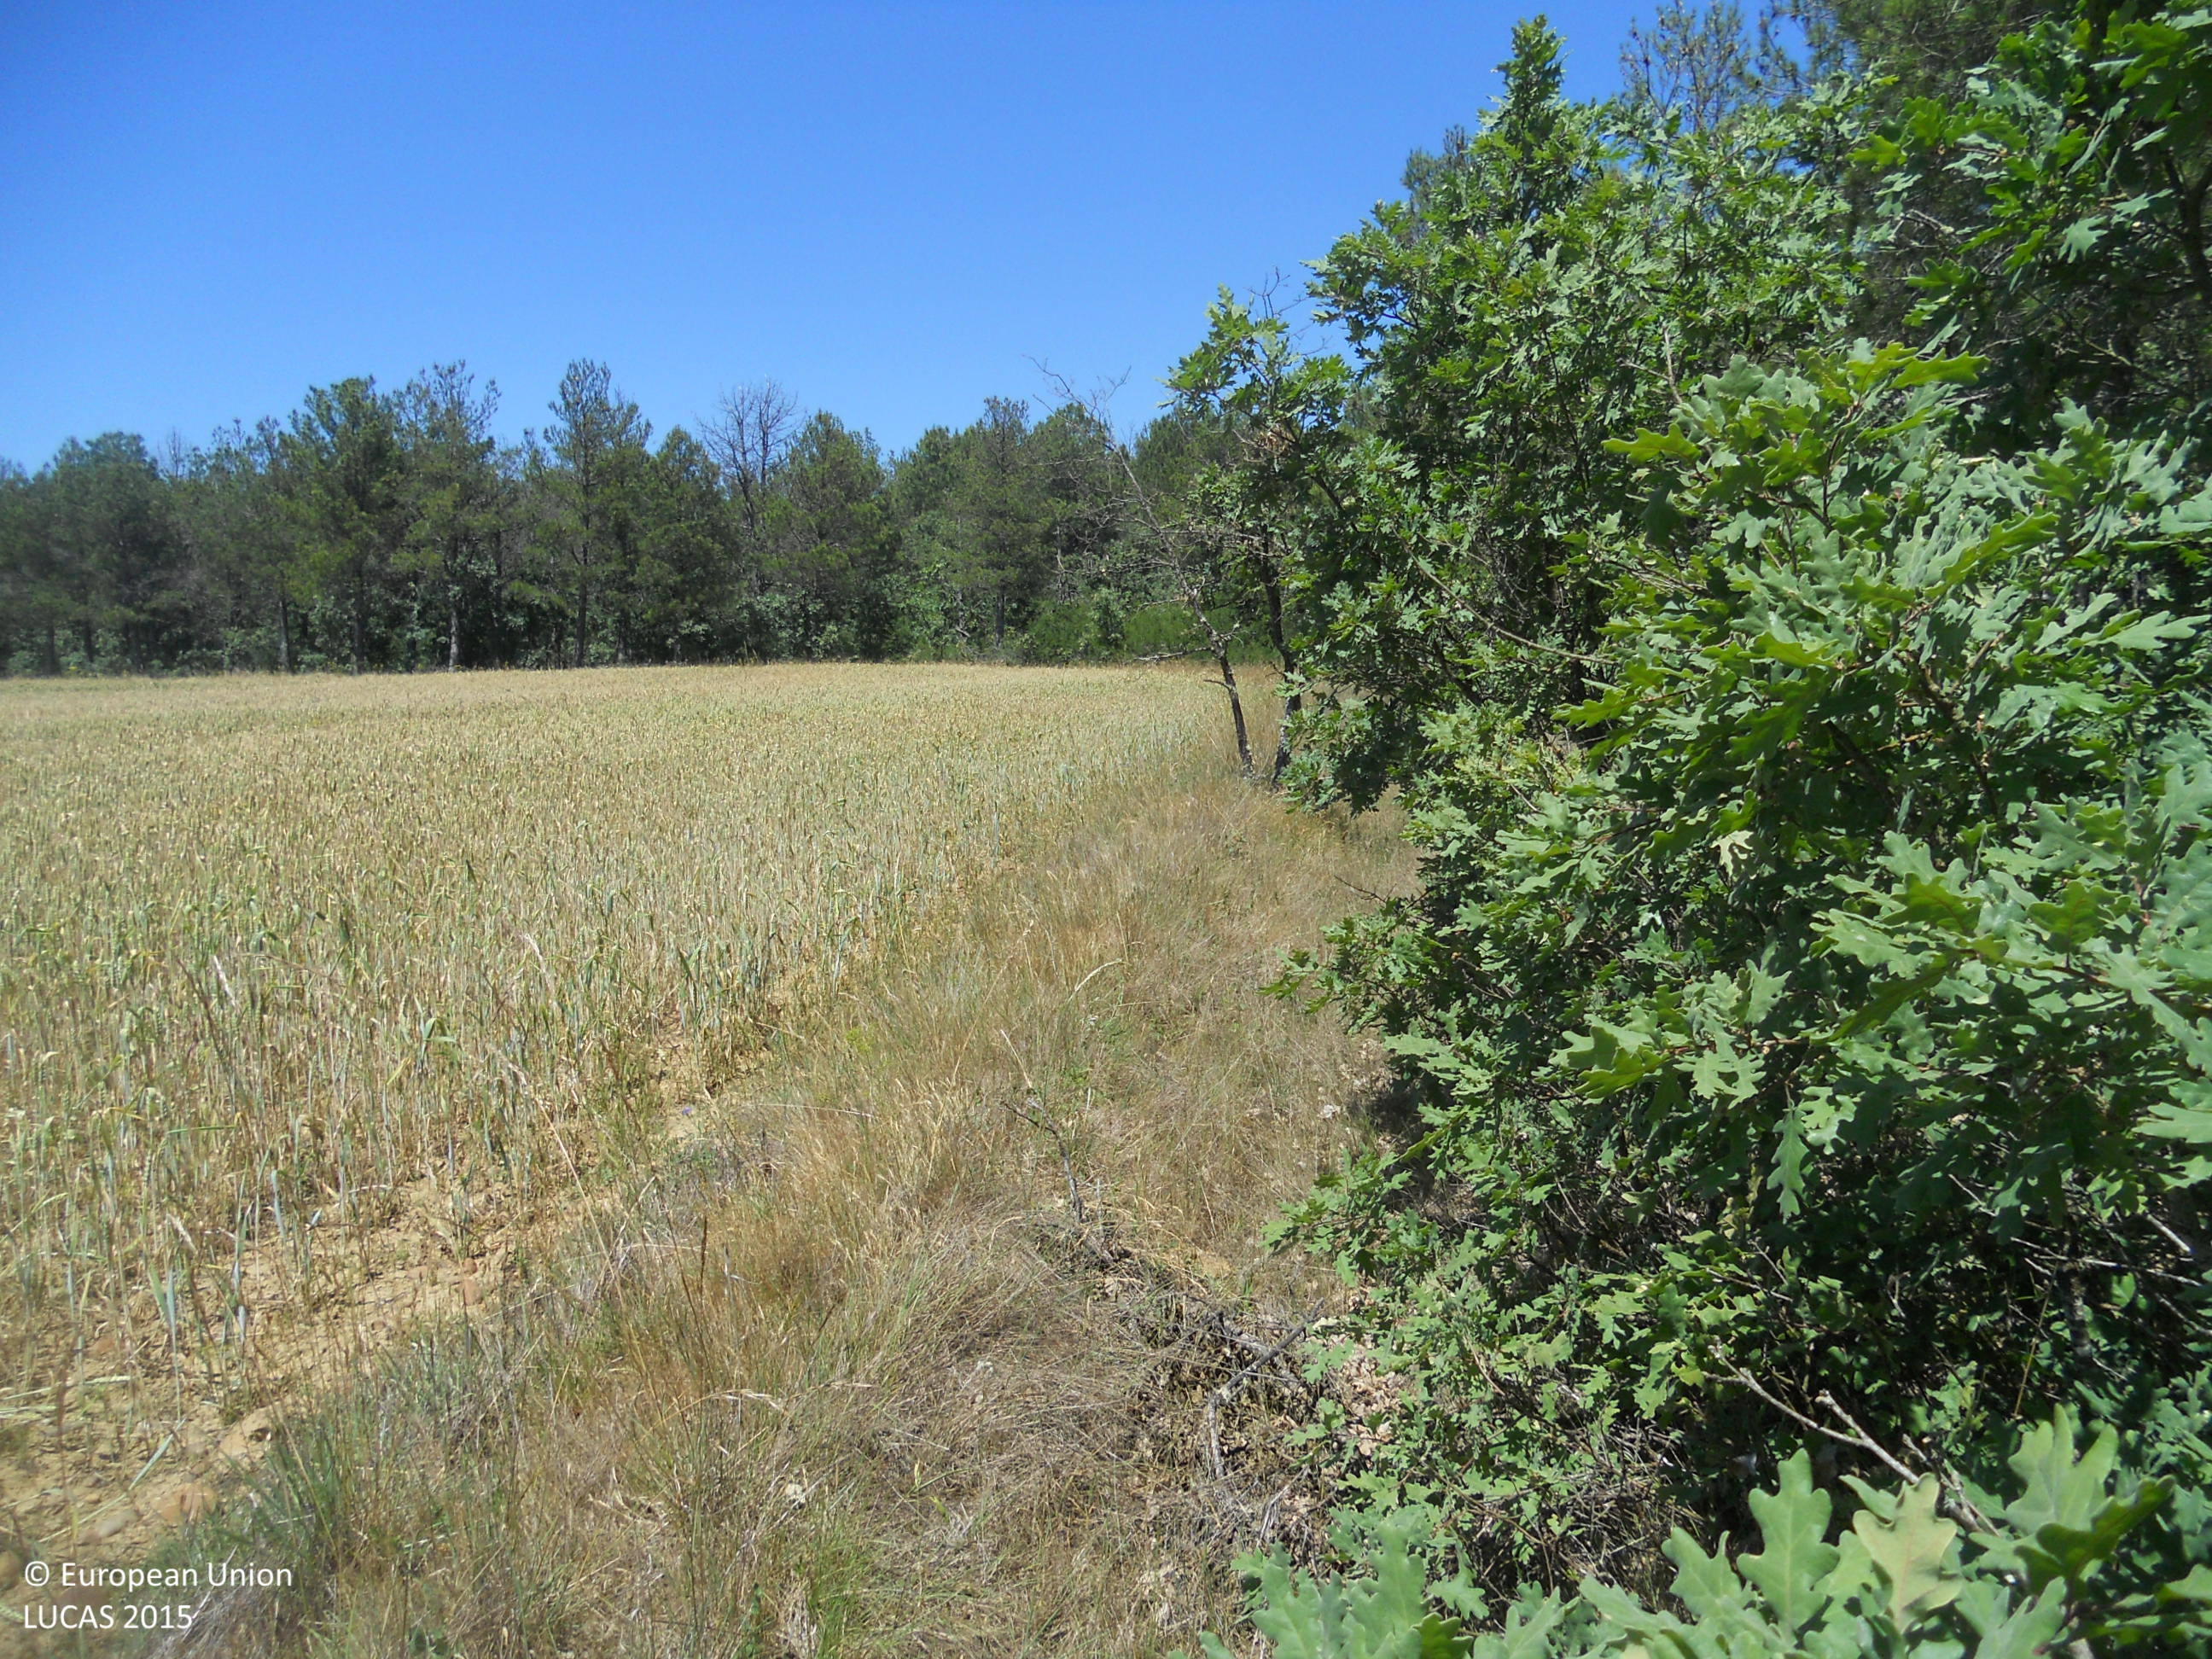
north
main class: Woodland
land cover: Pine dominated coniferous woodland
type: coniferous forest of the mediterranean region
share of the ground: > 75 %
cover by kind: coniferous forest trees 60 %, broadleaved forest trees 20 %, shrubs 10 %, herbaceous plants 10 %
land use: Forestry
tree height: > 5 m
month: June
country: ES
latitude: 42.4676
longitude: -4.8586
